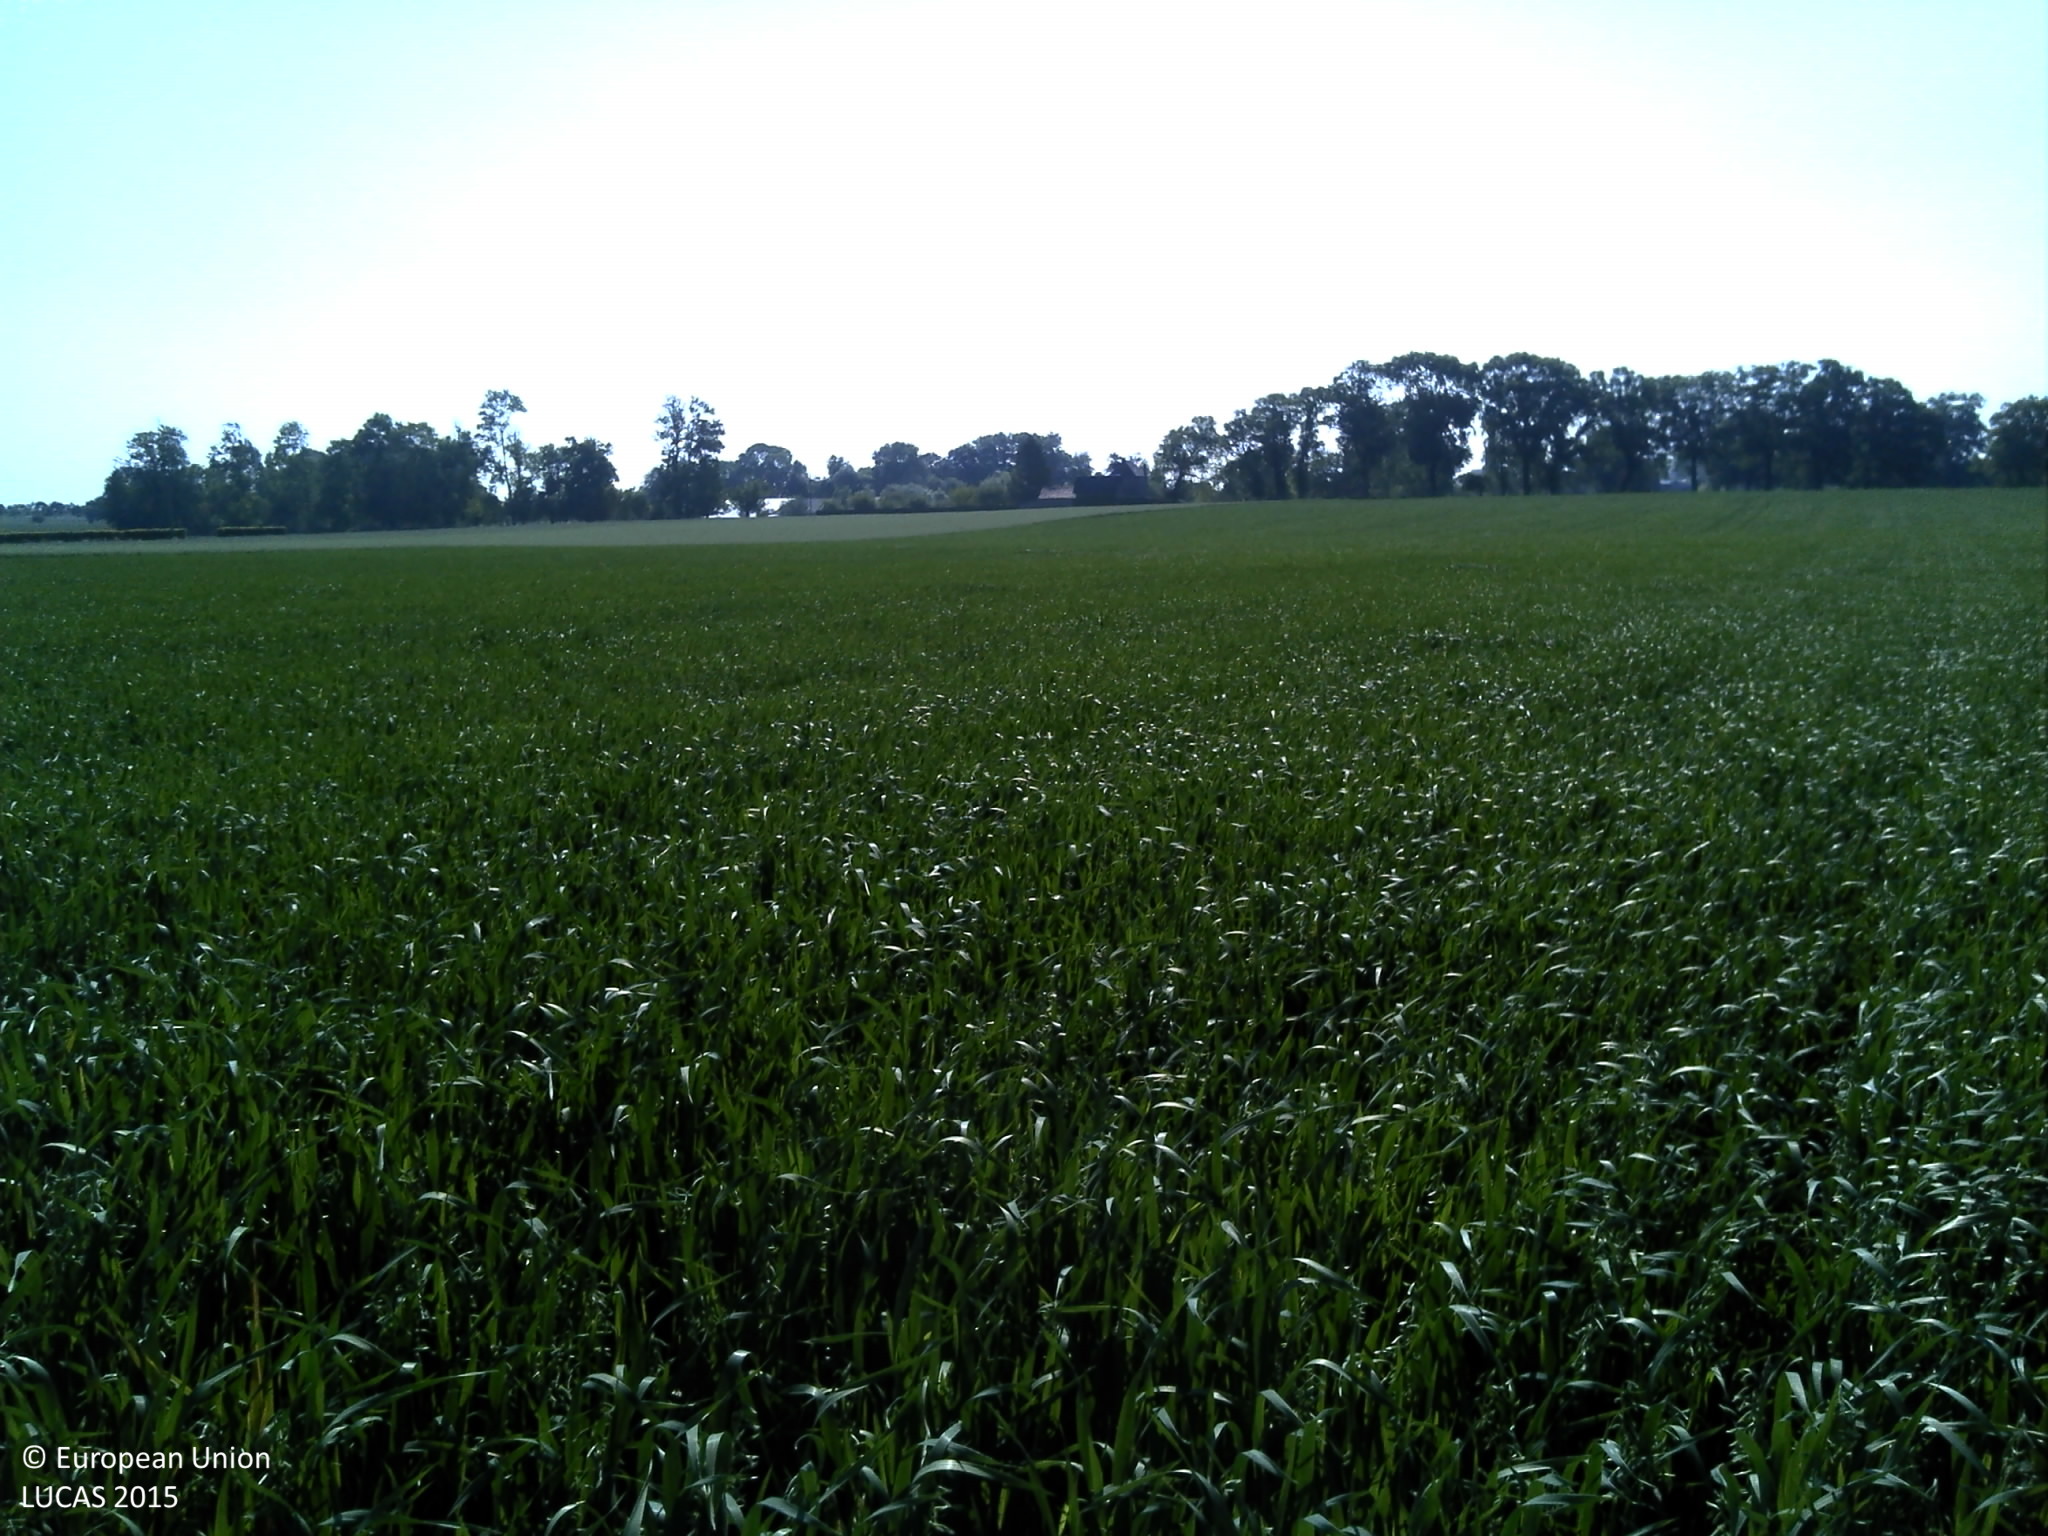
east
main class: Cropland
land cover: Oats
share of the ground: > 75 %
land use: Agriculture (excluding fallow land and kitchen gardens)
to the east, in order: Oats
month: June
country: FR
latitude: 49.6346
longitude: 1.0751
